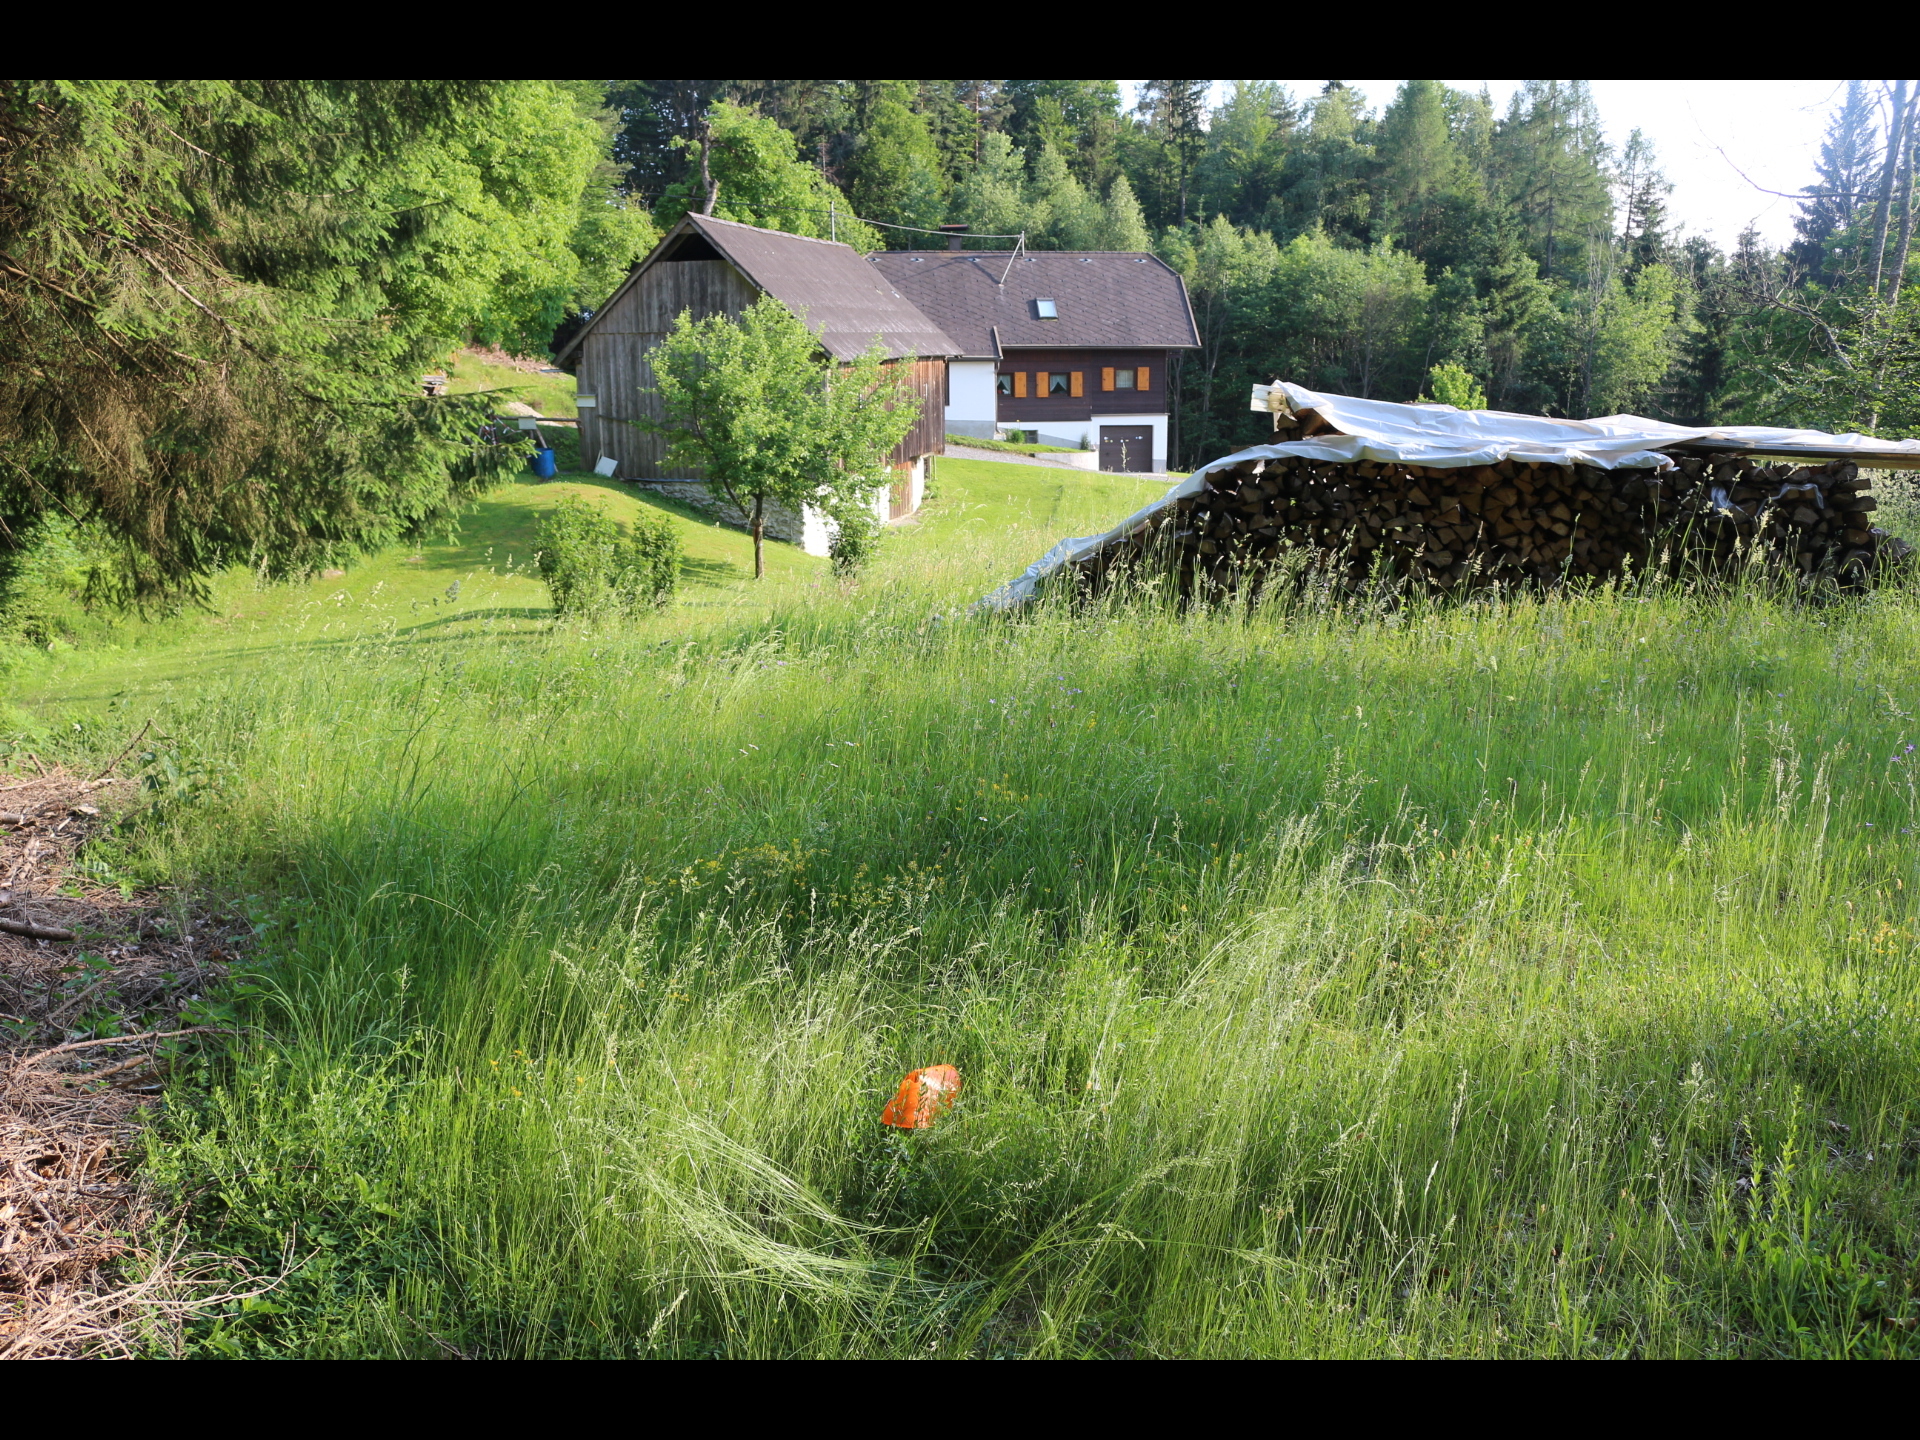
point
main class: Grassland
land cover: Grassland without tree/shrub cover
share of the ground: > 75 %
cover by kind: herbaceous plants 100 %
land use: Agriculture (excluding fallow land and kitchen gardens)
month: June
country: AT
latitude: 46.6557
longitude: 13.9829
